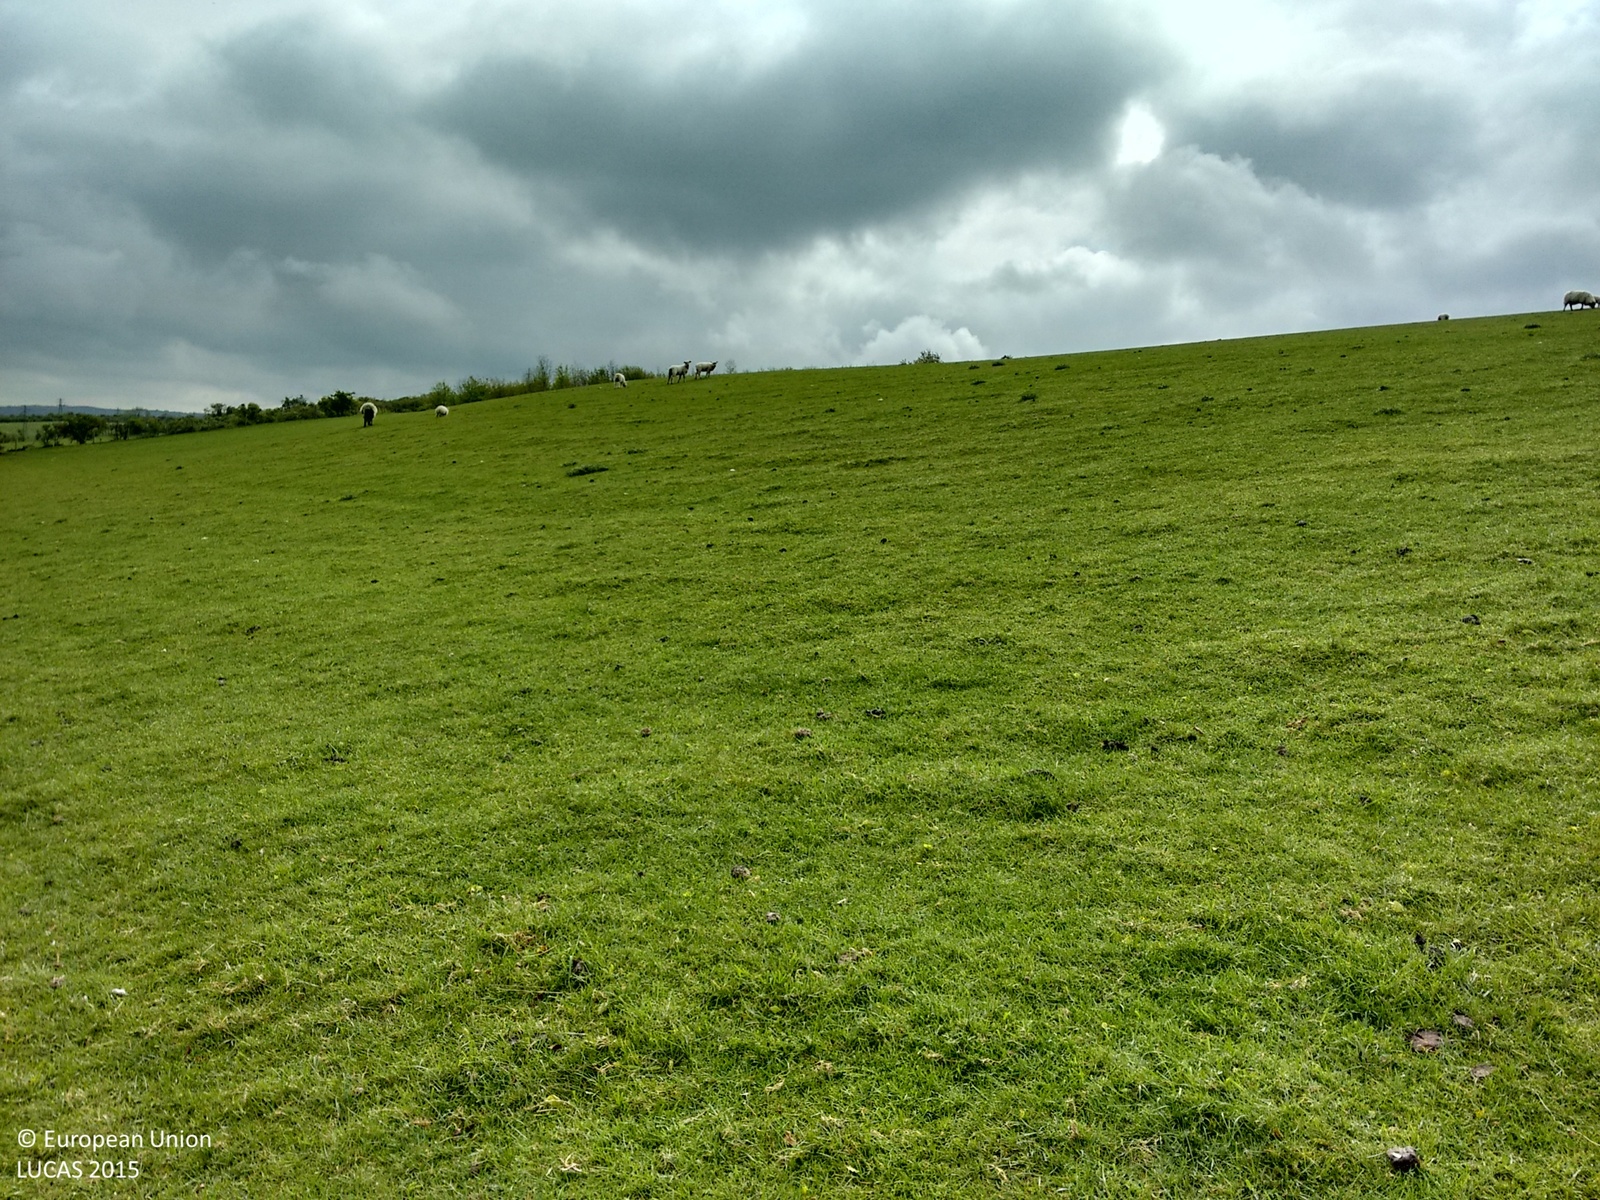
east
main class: Grassland
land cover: Grassland without tree/shrub cover
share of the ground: > 75 %
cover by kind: herbaceous plants 100 %
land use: Agriculture (excluding fallow land and kitchen gardens)
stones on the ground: < 10 %
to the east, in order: Grassland without tree/shrub cover; Tracks; Fences; Broadleaved woodland
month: May
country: GB
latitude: 51.8451
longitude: -0.6217
